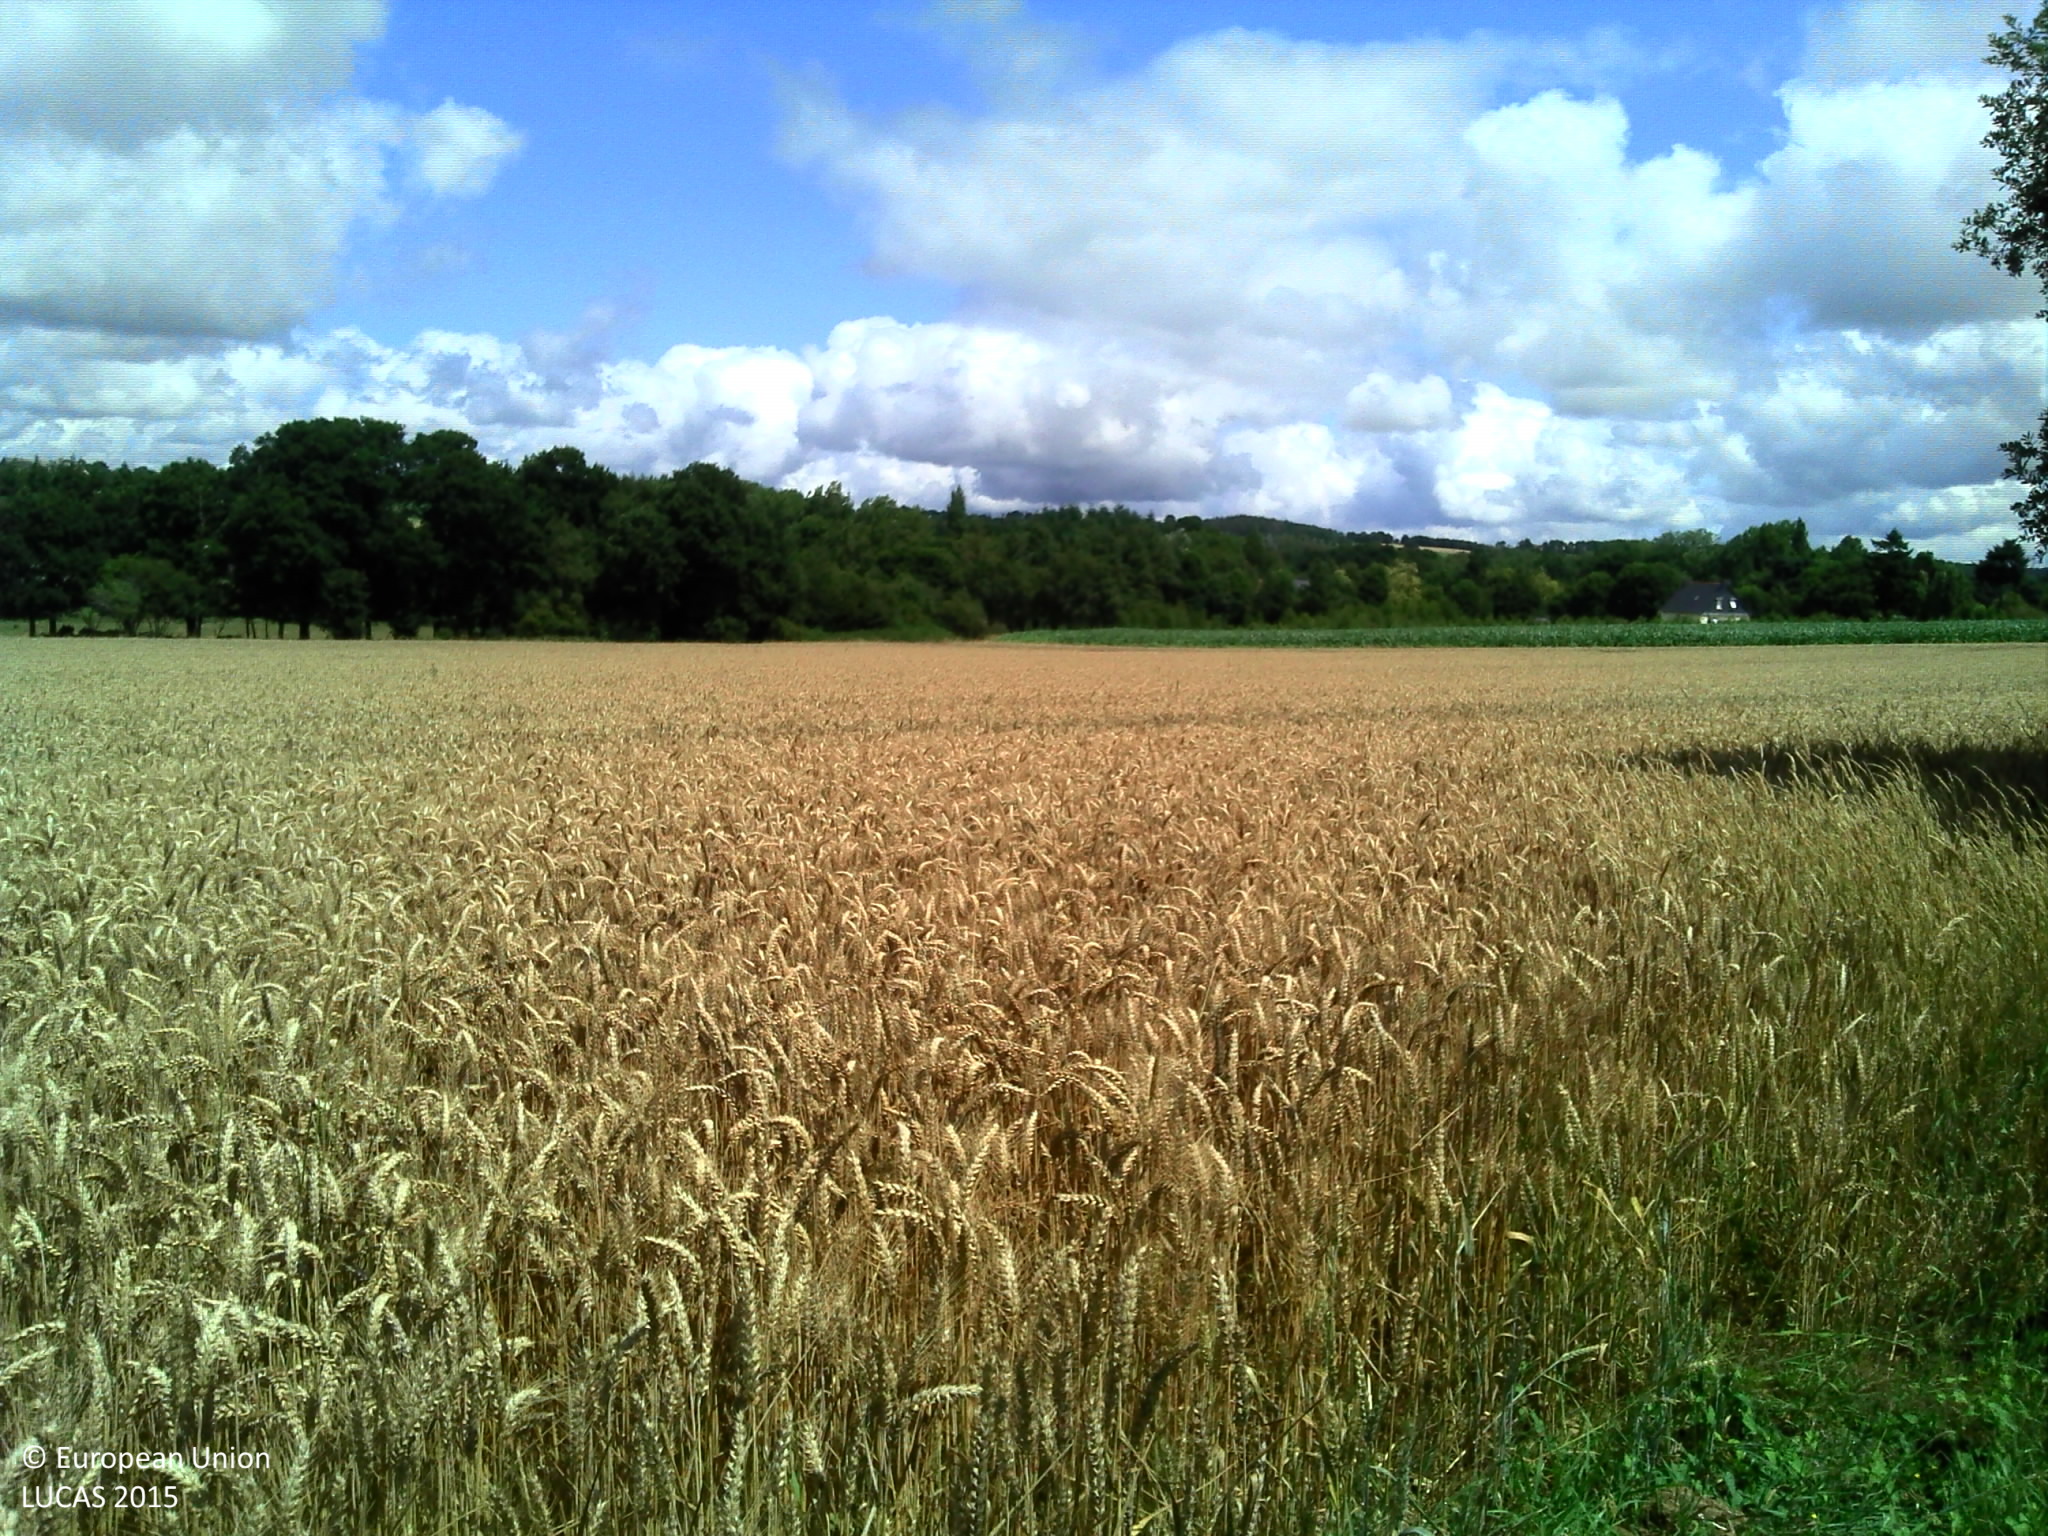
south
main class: Cropland
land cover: Maize
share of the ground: > 75 %
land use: Agriculture (excluding fallow land and kitchen gardens)
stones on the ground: < 10 %
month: July
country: FR
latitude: 48.2741
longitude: -2.3330
